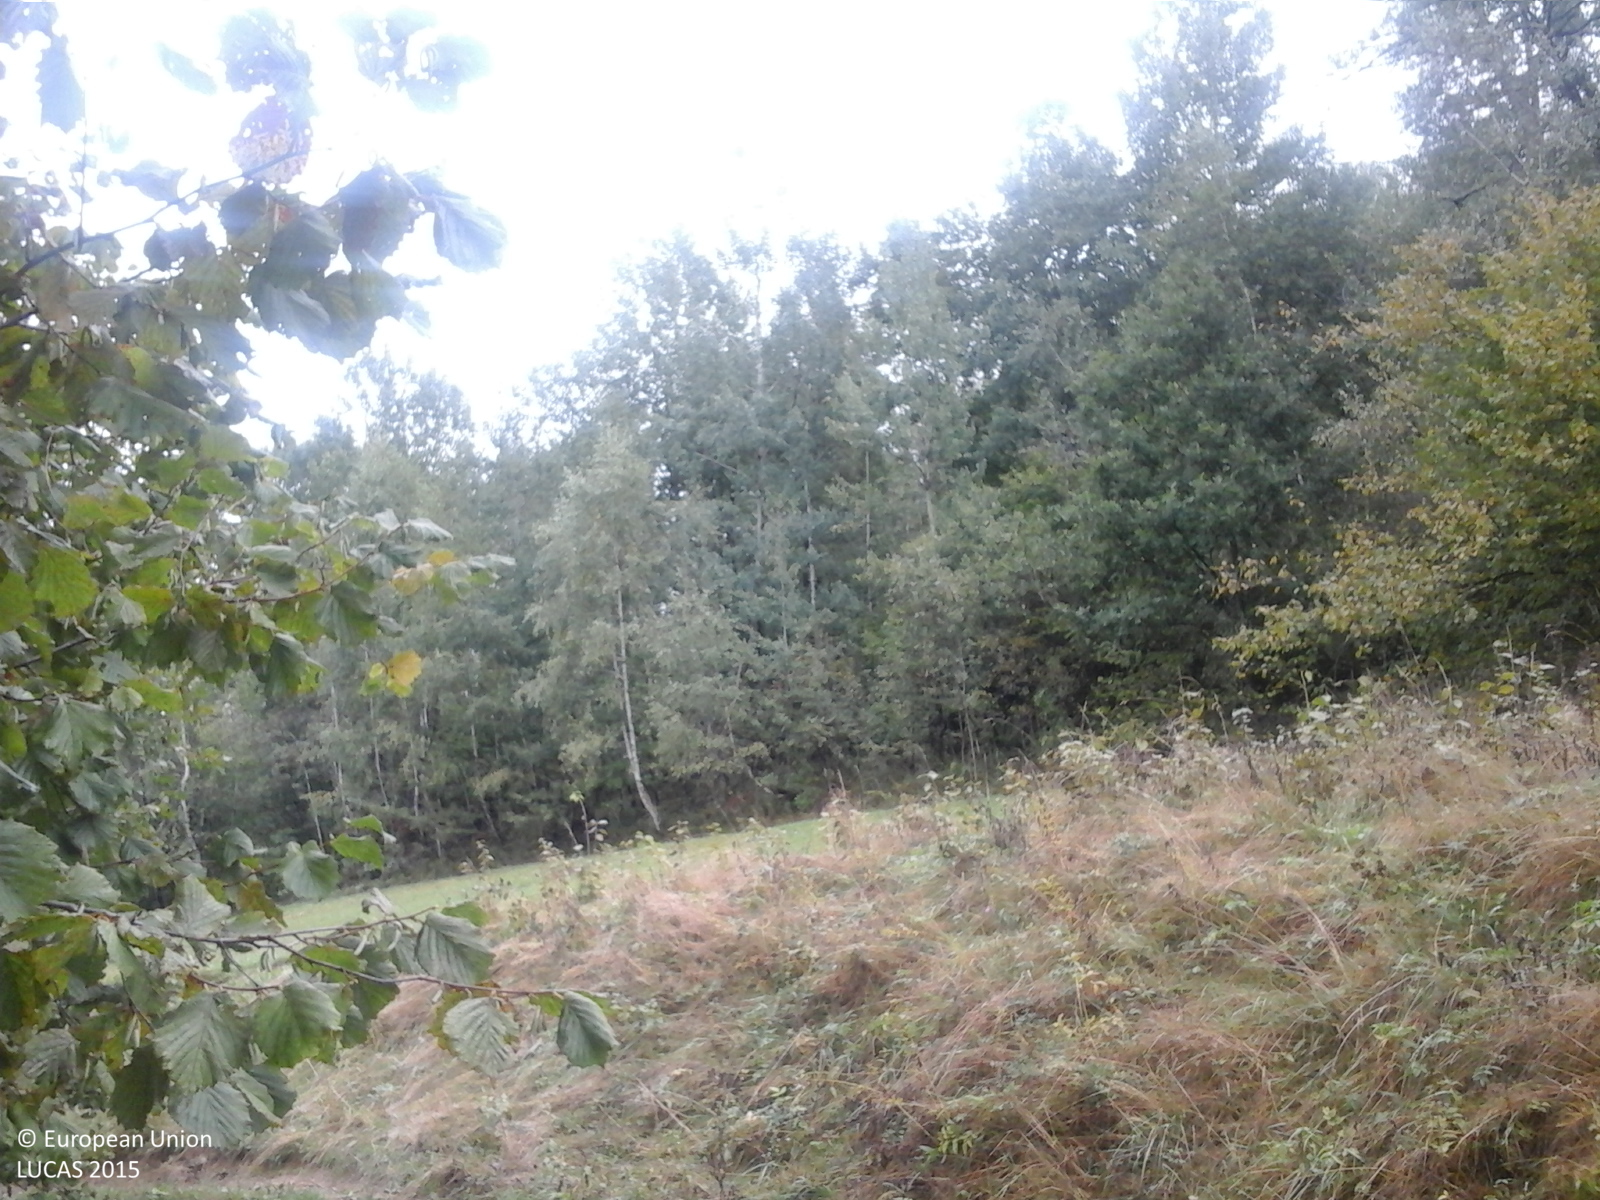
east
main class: Grassland
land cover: Grassland with sparse tree/shrub cover
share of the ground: > 75 %
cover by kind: herbaceous plants 85 %, shrubs 10 %, broadleaved forest trees 5 %
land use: Agriculture (excluding fallow land and kitchen gardens)
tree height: < 5 m
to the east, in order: Grassland with sparse tree/shrub cover; Tracks; Grassland without tree/shrub cover; Broadleaved woodland; Tracks; Fences; Grassland without tree/shrub cover; Other fruit trees and berries; Grassland without tree/shrub cover; Grassland with sparse tree/shrub cover
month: September
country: RO
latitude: 45.8023
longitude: 23.7709
